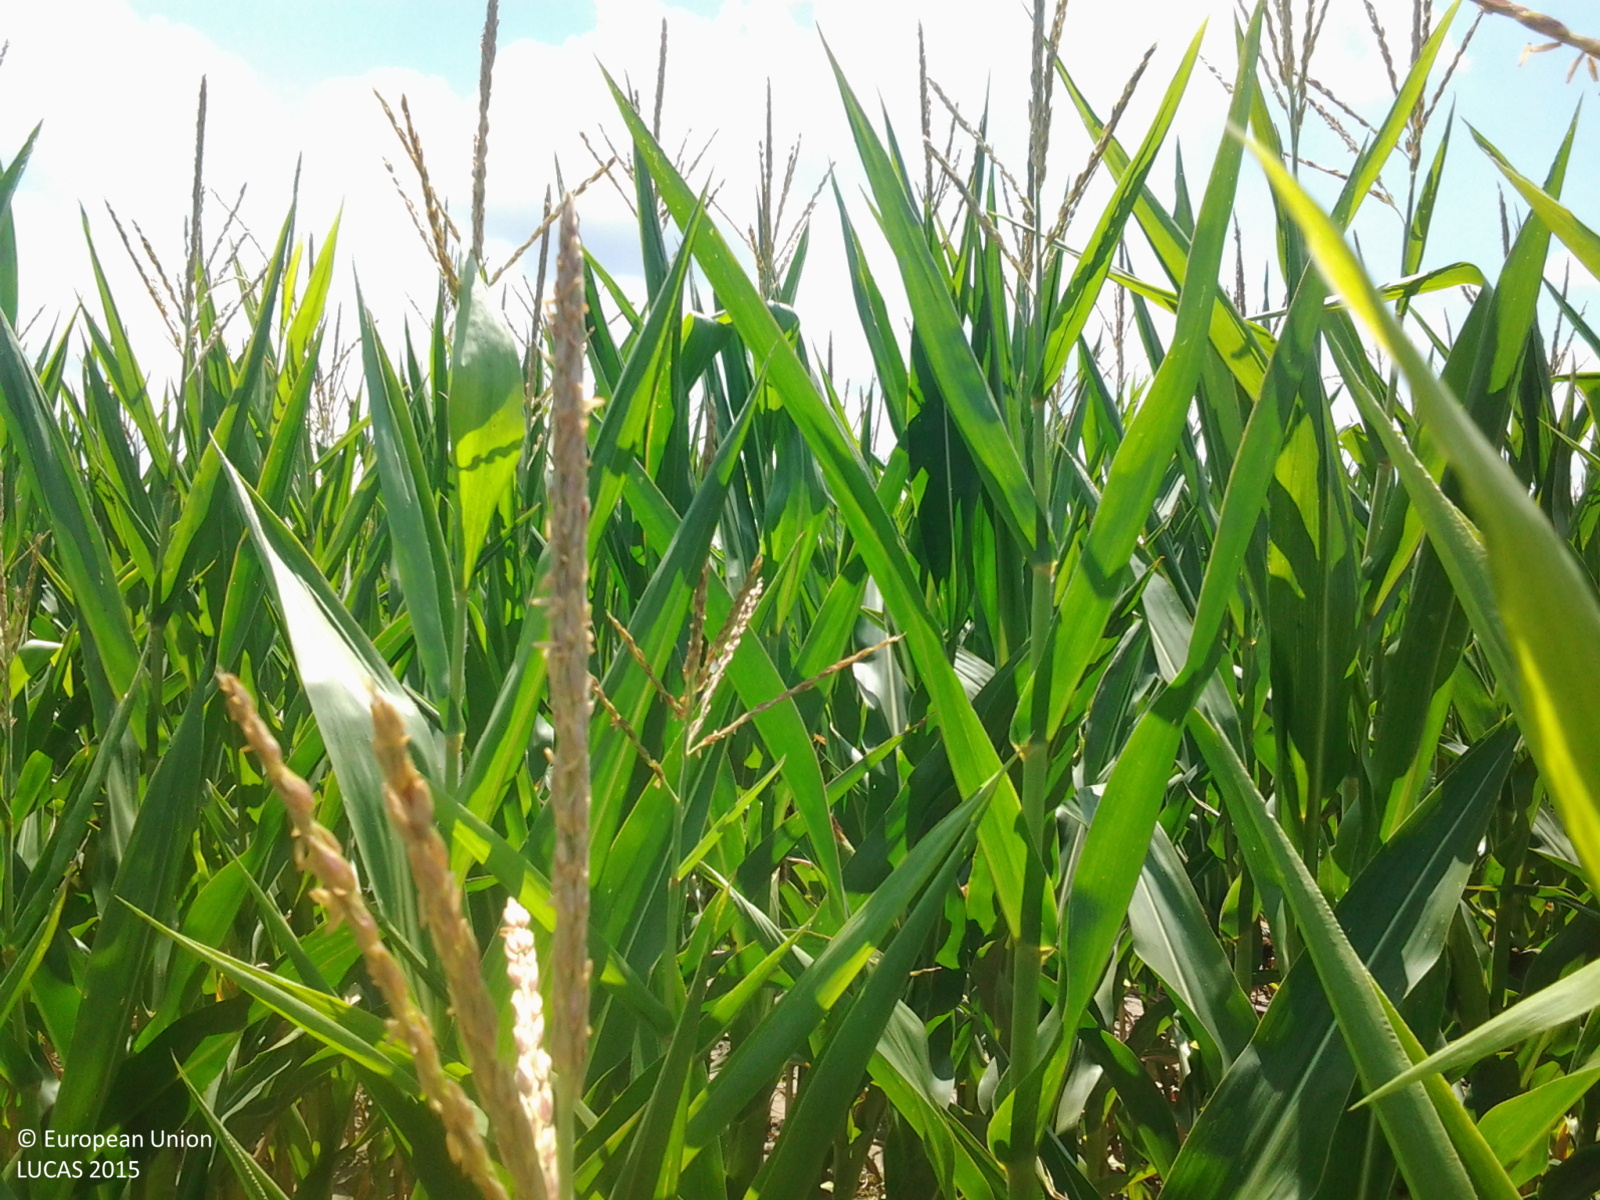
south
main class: Cropland
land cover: Maize
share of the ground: > 75 %
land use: Agriculture (excluding fallow land and kitchen gardens)
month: July
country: HU
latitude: 46.7300
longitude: 21.4886
